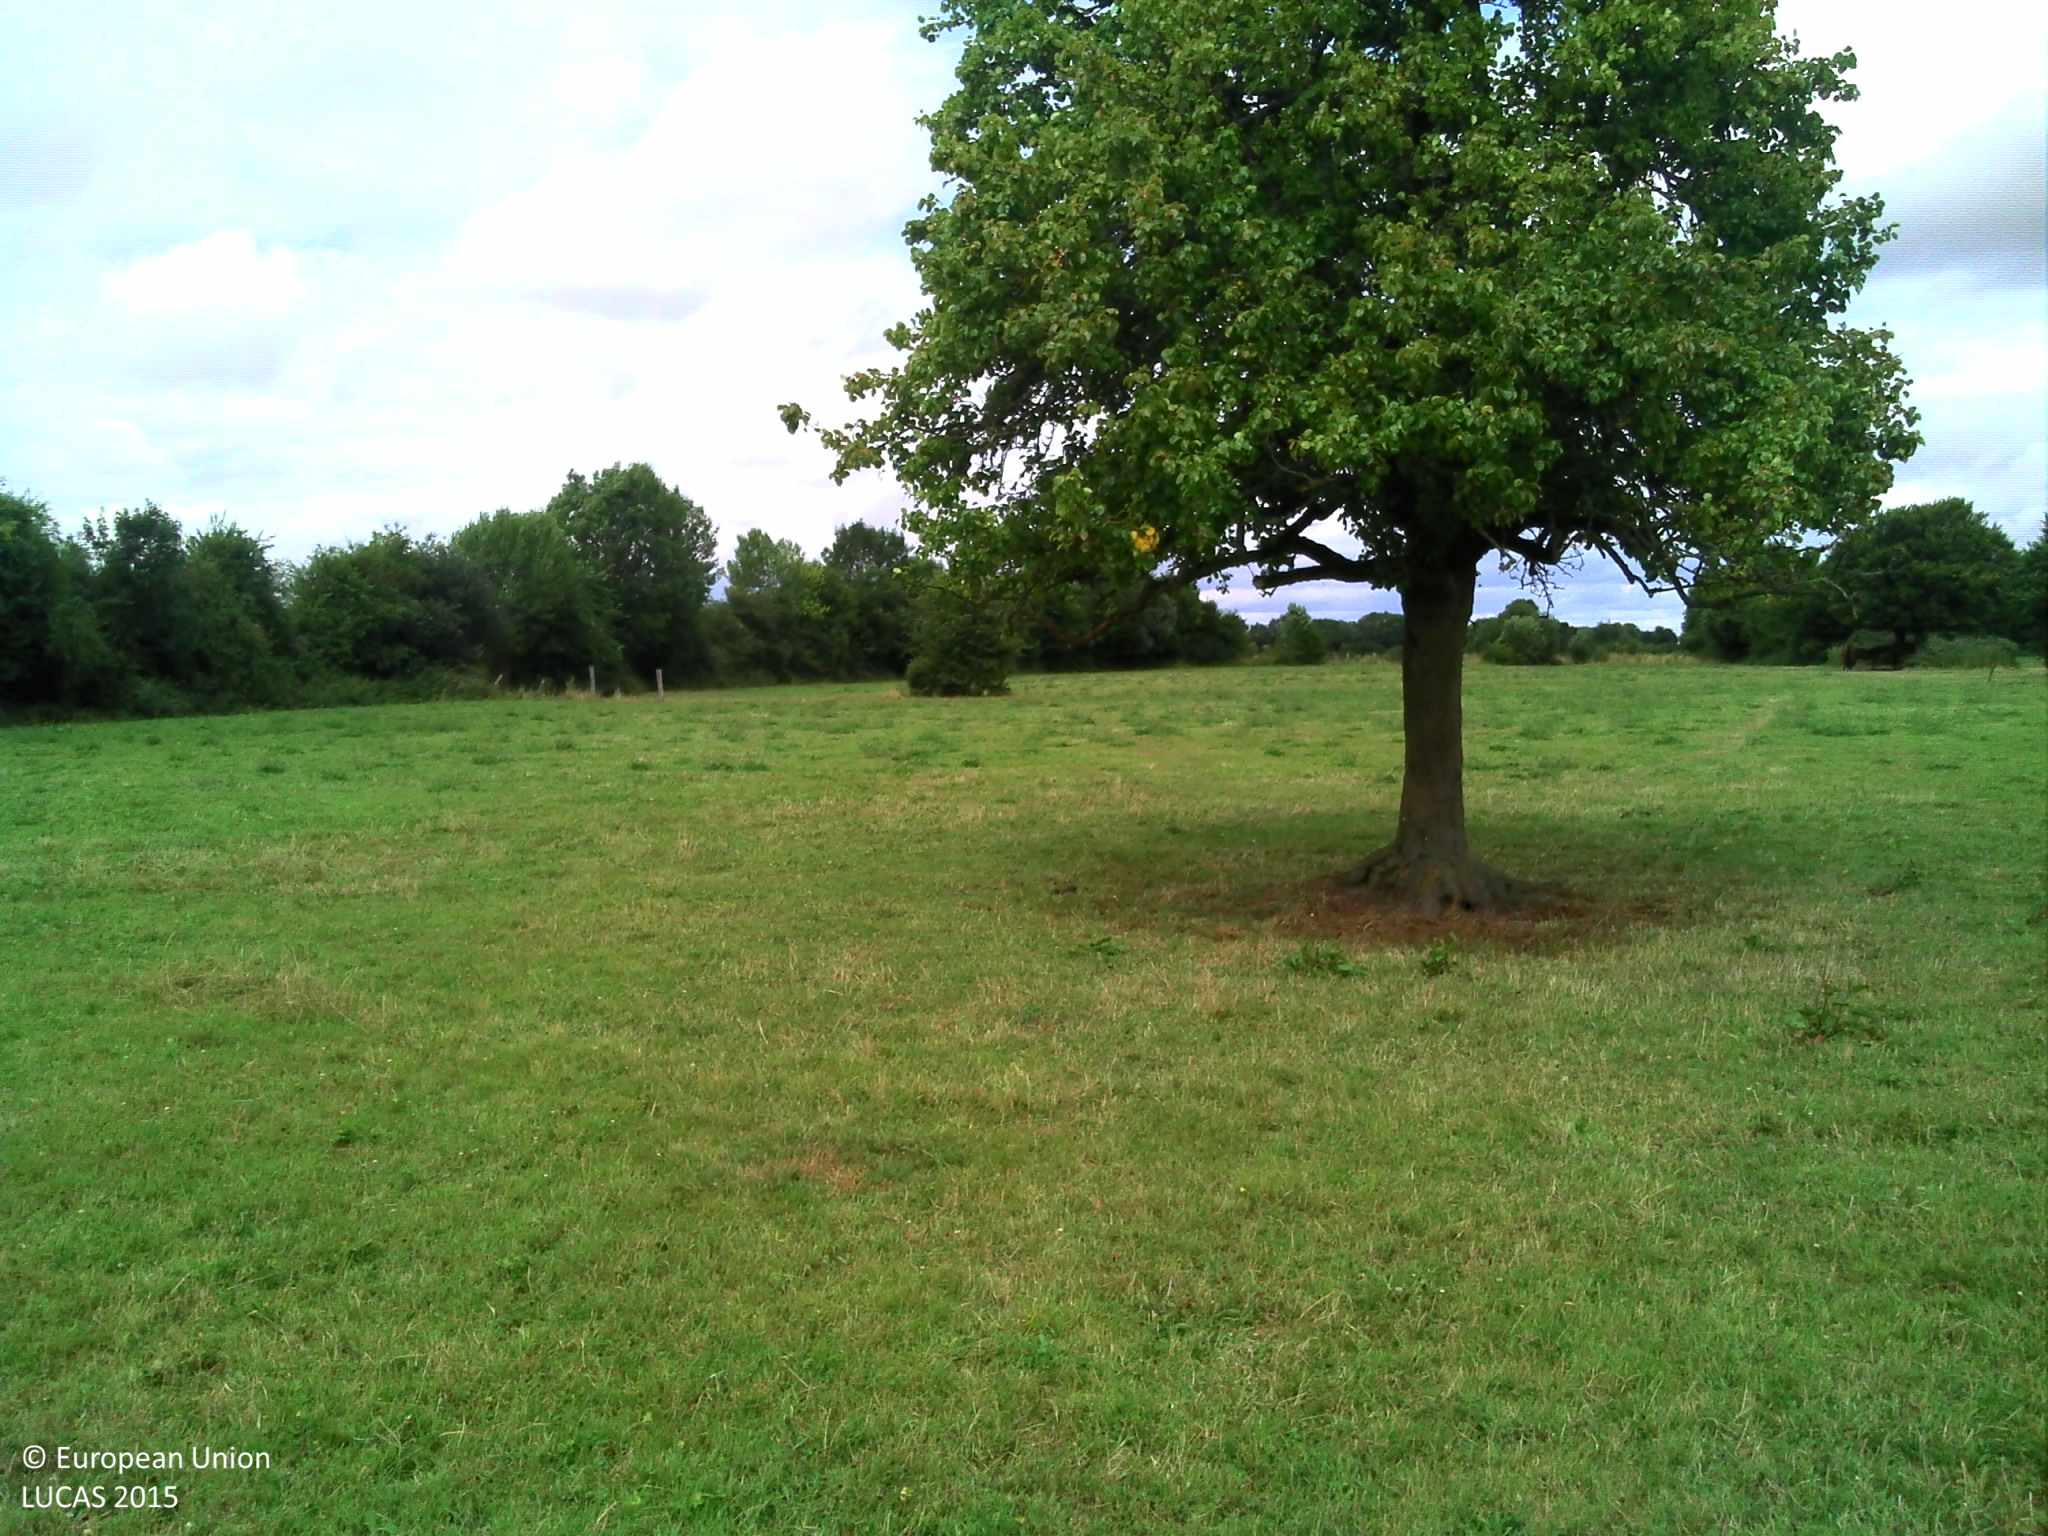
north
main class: Grassland
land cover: Grassland without tree/shrub cover
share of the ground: > 75 %
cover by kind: herbaceous plants 100 %
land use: Agriculture (excluding fallow land and kitchen gardens)
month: July
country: FR
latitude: 48.8608
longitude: 0.4734
